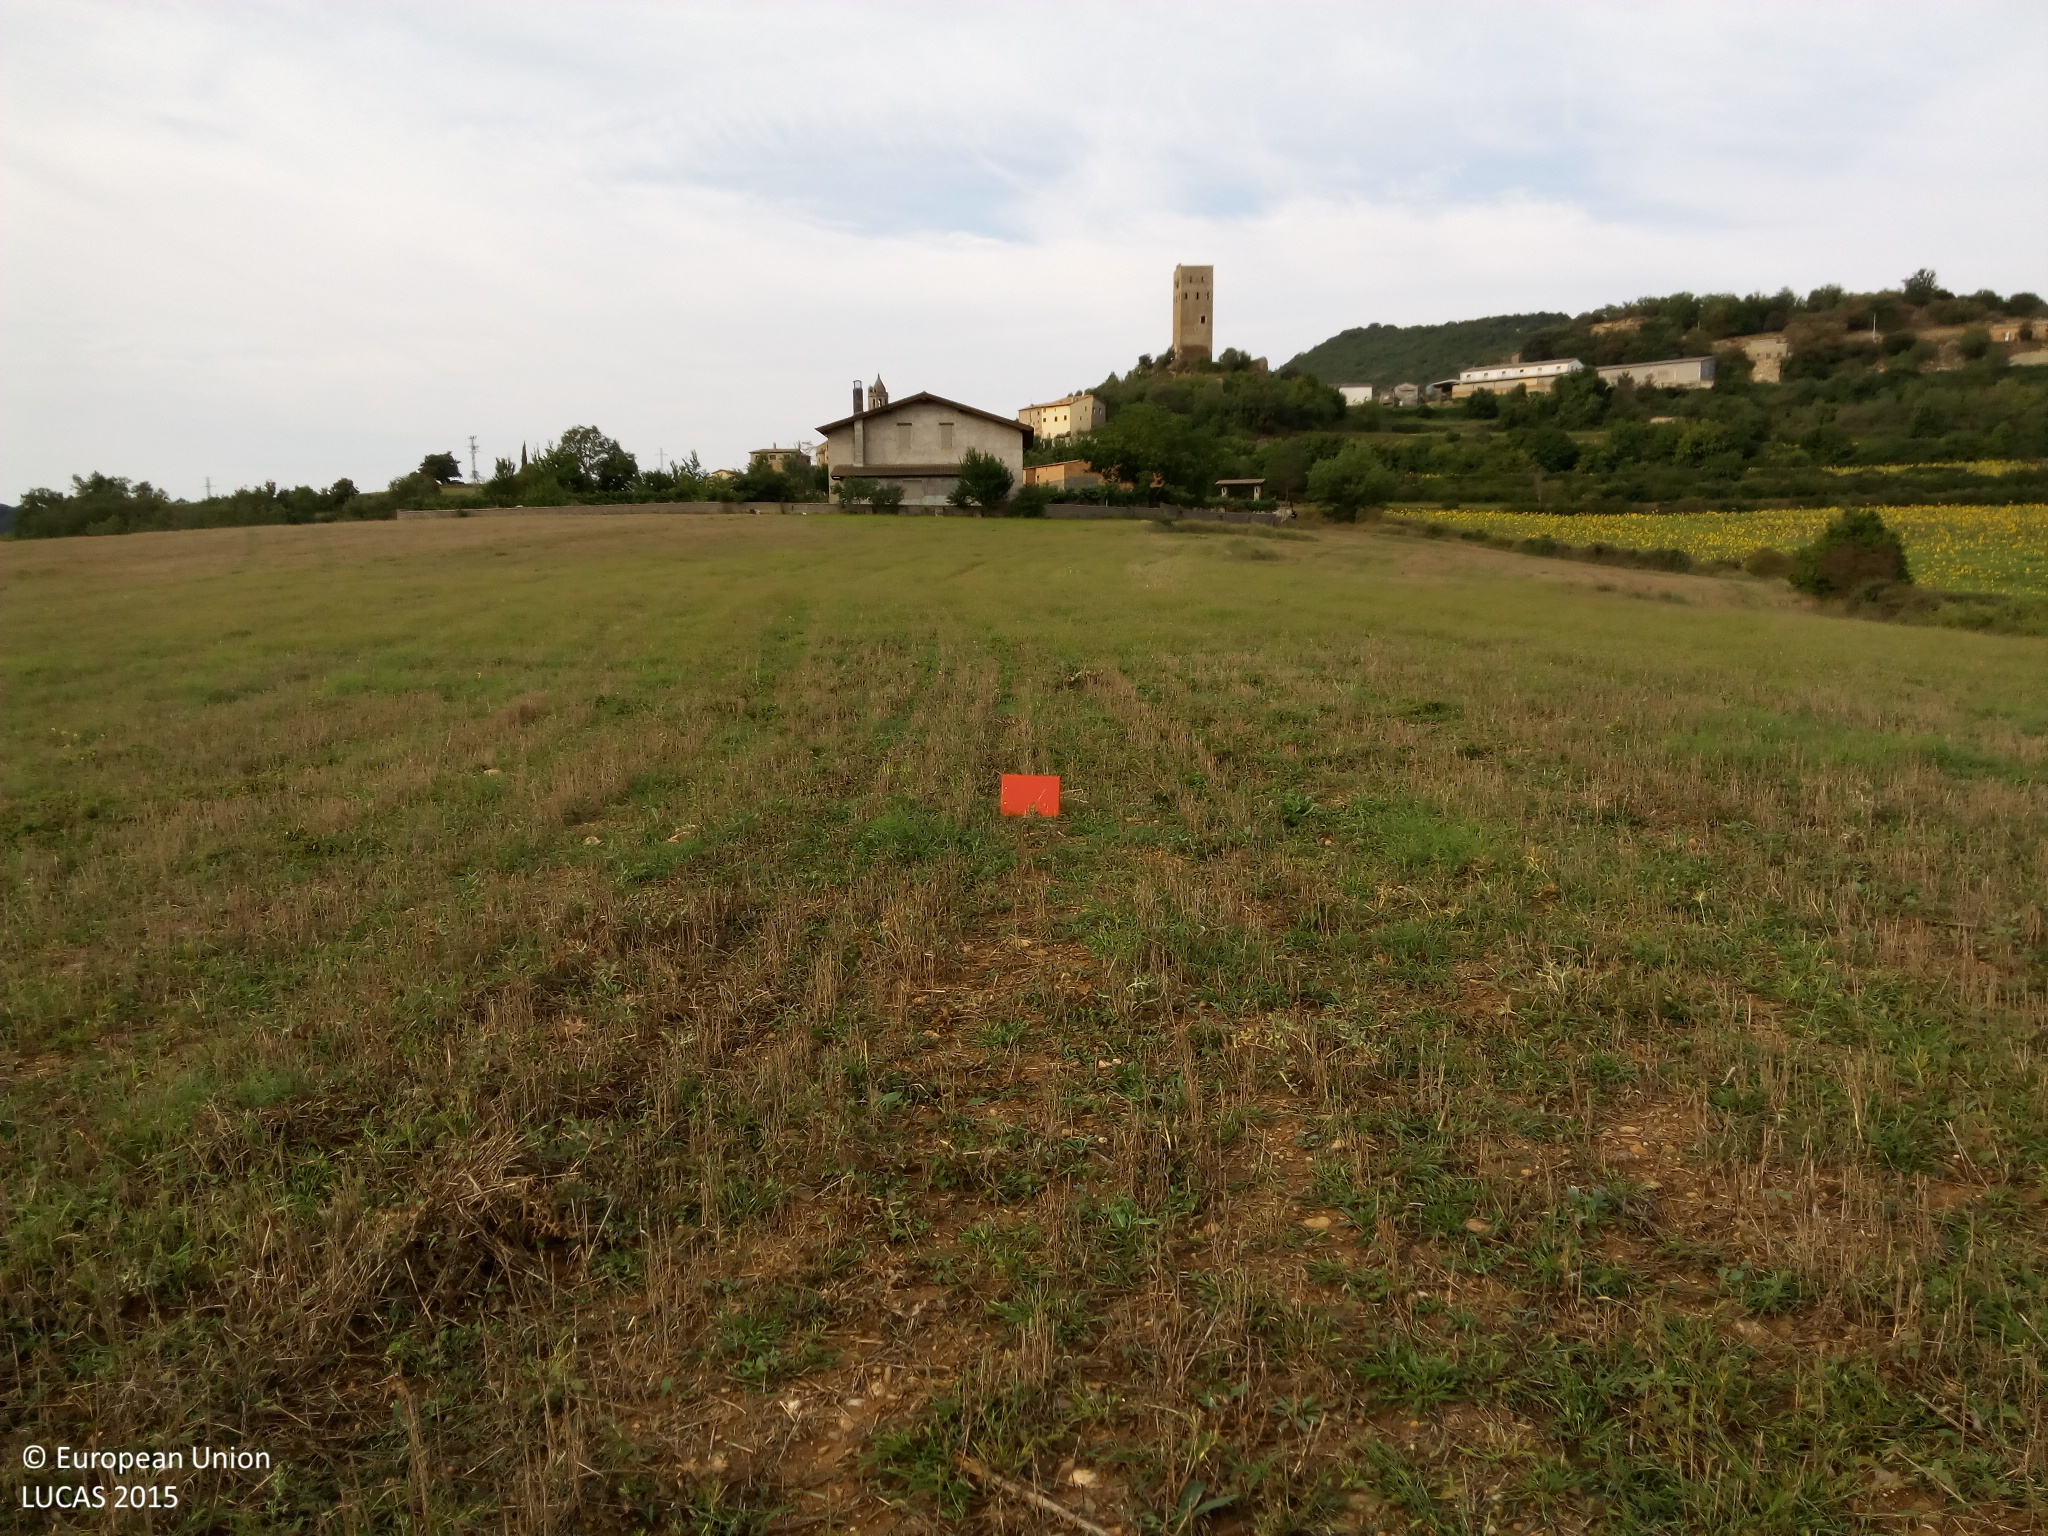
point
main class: Cropland
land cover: Common wheat
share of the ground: < 10 %
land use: Agriculture (excluding fallow land and kitchen gardens)
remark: Harvested field
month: August
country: ES
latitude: 42.1595
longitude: 0.5792
